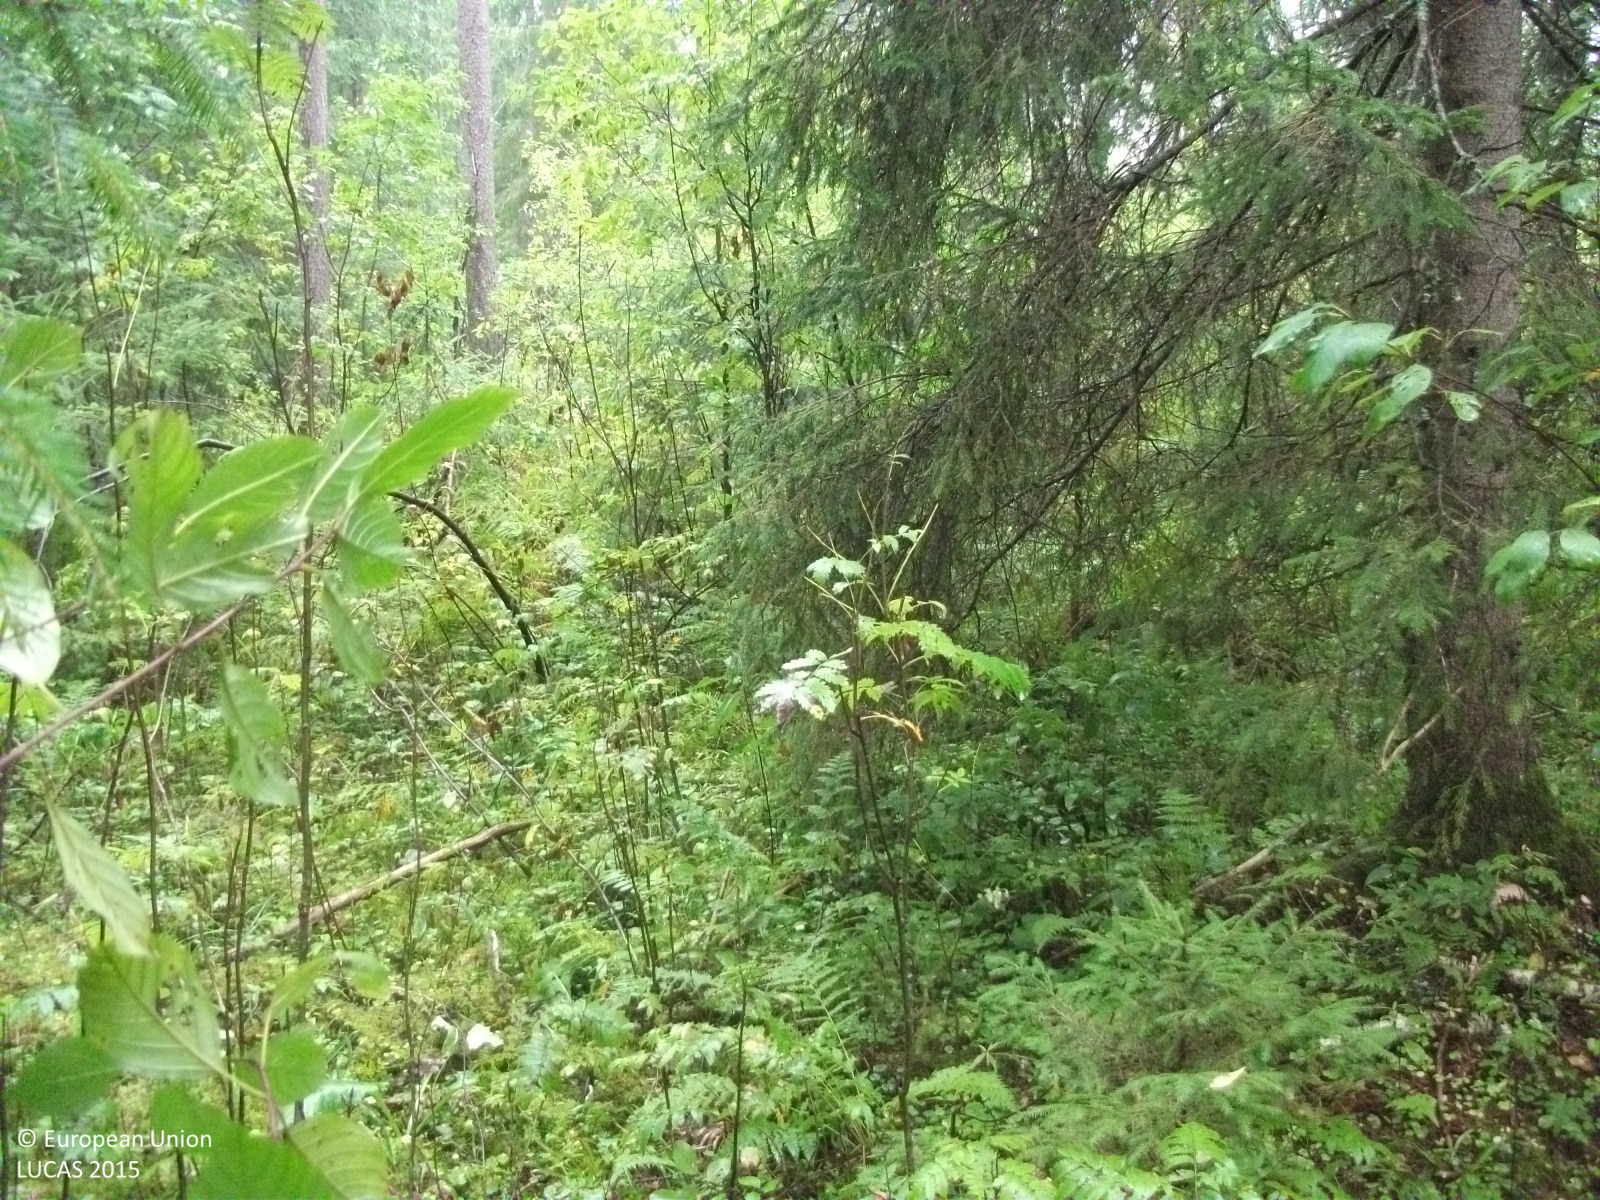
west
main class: Woodland
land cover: Spruce dominated mixed woodland
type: hemiboreal forest and nemoral coniferous forest and mixed broadleaved-coniferous forest
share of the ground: > 75 %
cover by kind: coniferous forest trees 55 %, broadleaved forest trees 30 %, herbaceous plants 10 %, shrubs 5 %
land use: Forestry
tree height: > 5 m
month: September
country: LV
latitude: 56.5975
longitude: 26.0804
